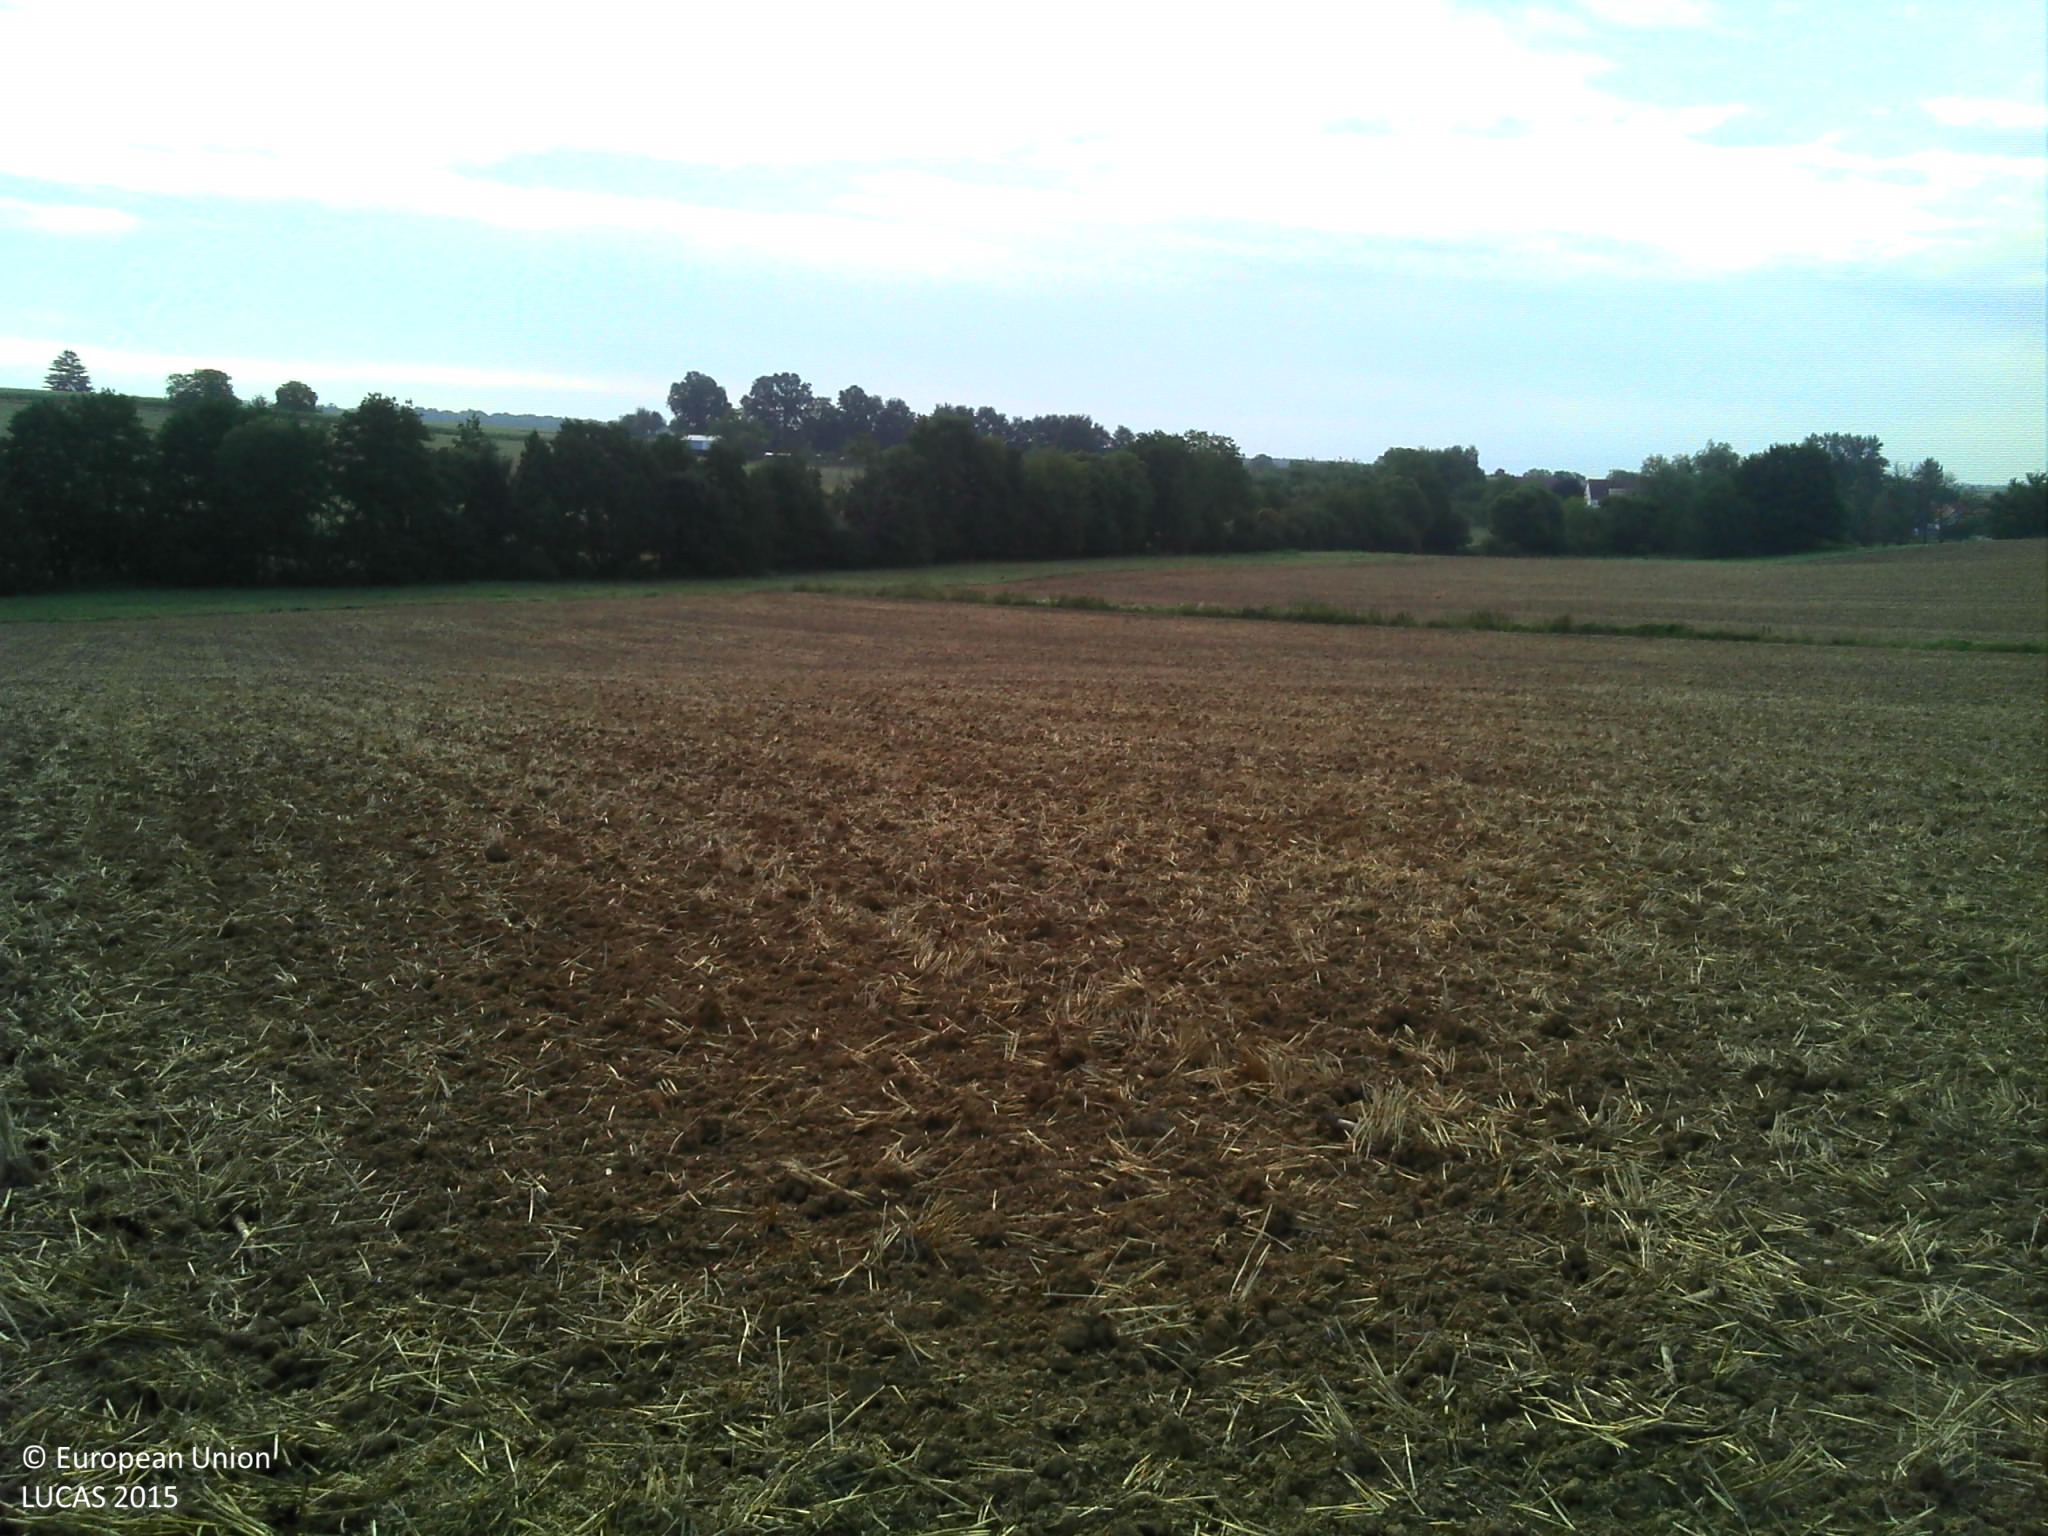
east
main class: Cropland
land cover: Common wheat
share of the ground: < 10 %
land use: Agriculture (excluding fallow land and kitchen gardens)
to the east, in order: Common wheat; Grassland without tree/shrub cover; Lines of trees; Rivers and streams; Fences; Grassland without tree/shrub cover; Fences; Grassland without tree/shrub cover; Fences; Grassland without tree/shrub cover
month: August
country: FR
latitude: 48.8638
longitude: 7.6151
